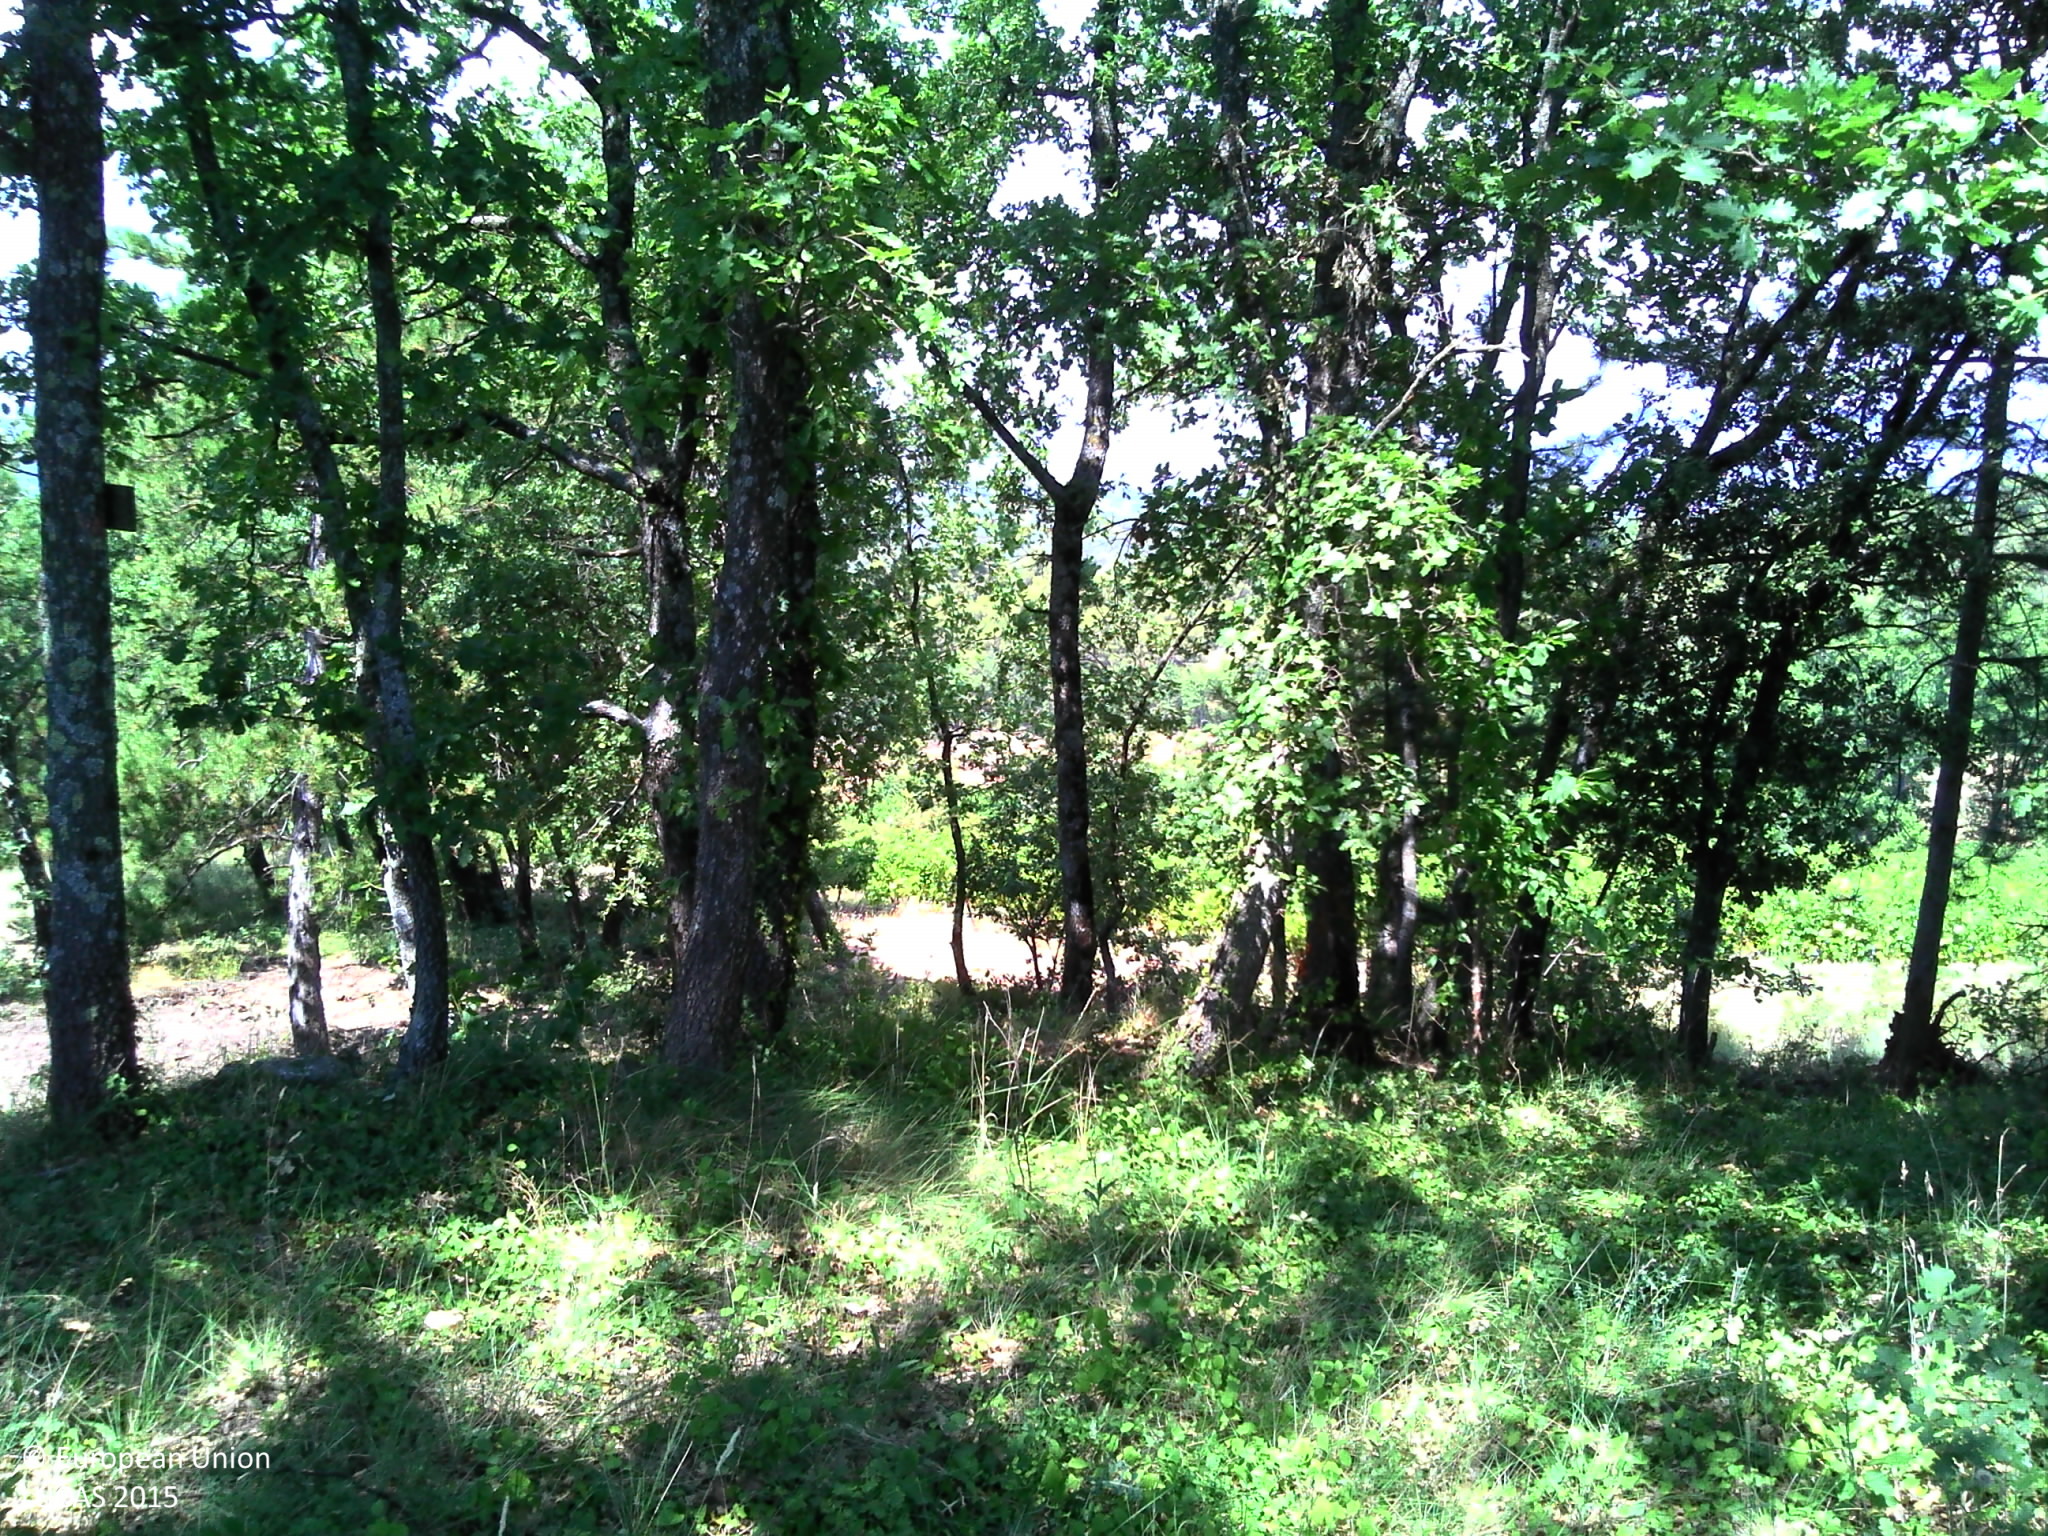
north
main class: Woodland
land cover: Broadleaved woodland
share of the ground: > 75 %
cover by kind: broadleaved forest trees 60 %, herbaceous plants 30 %, coniferous forest trees 5 %, shrubs 5 %
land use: Residential
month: August
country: FR
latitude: 43.8475
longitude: 5.3193
